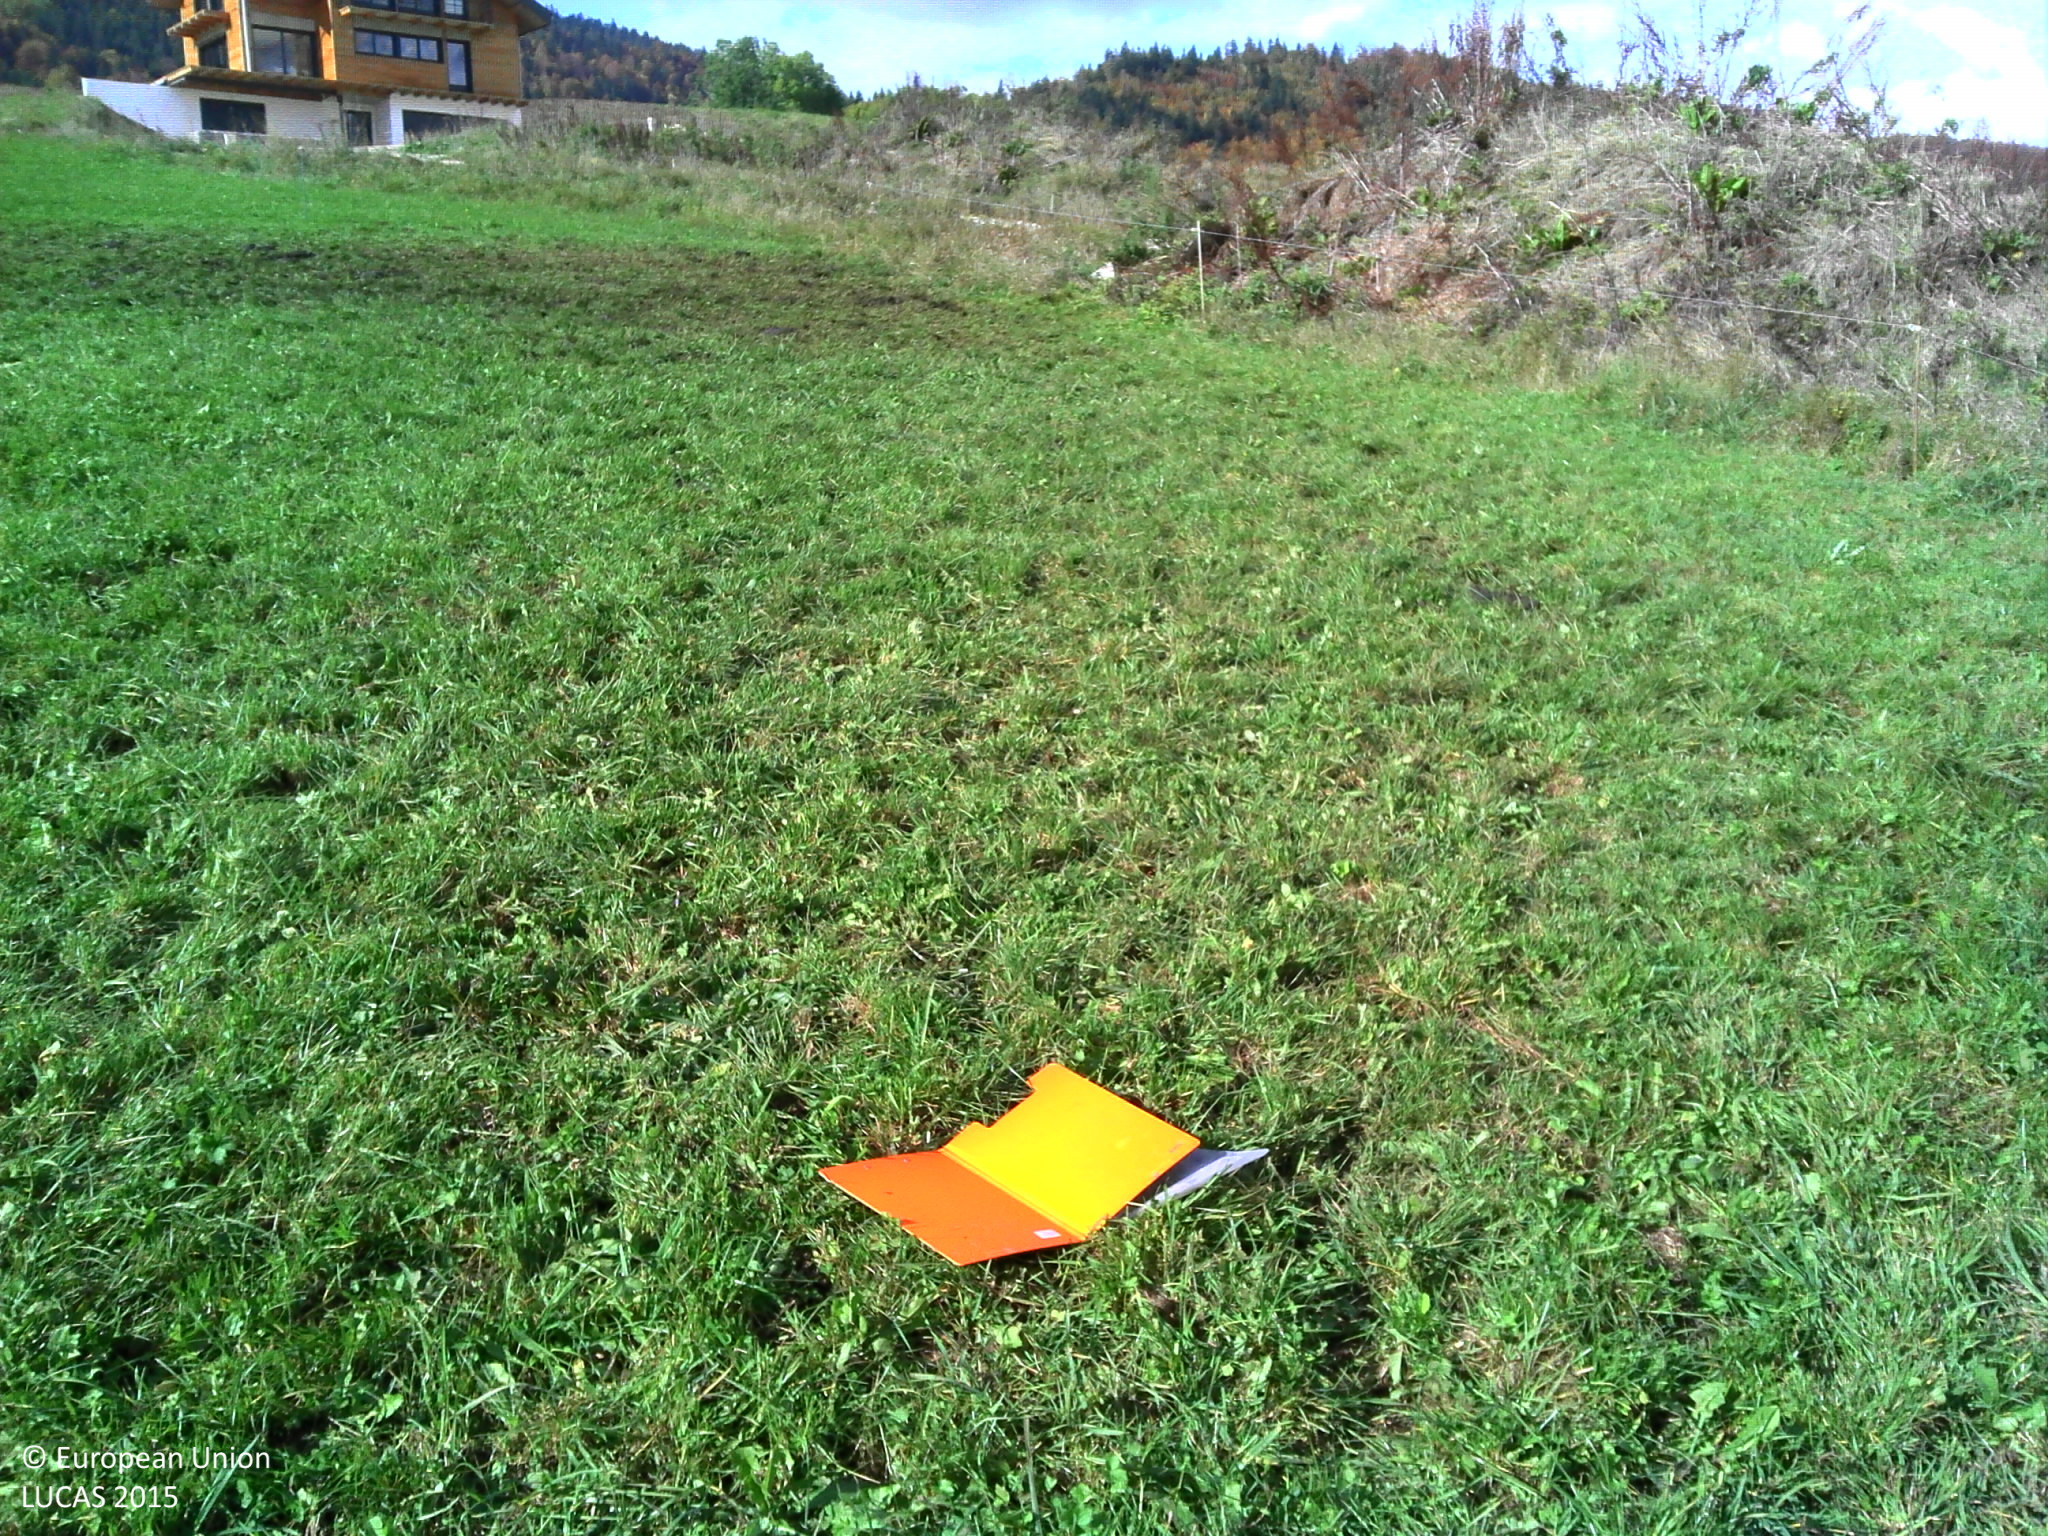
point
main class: Grassland
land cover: Grassland without tree/shrub cover
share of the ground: > 75 %
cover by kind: herbaceous plants 100 %
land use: Agriculture (excluding fallow land and kitchen gardens)
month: October
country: FR
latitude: 46.7406
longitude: 6.3773
